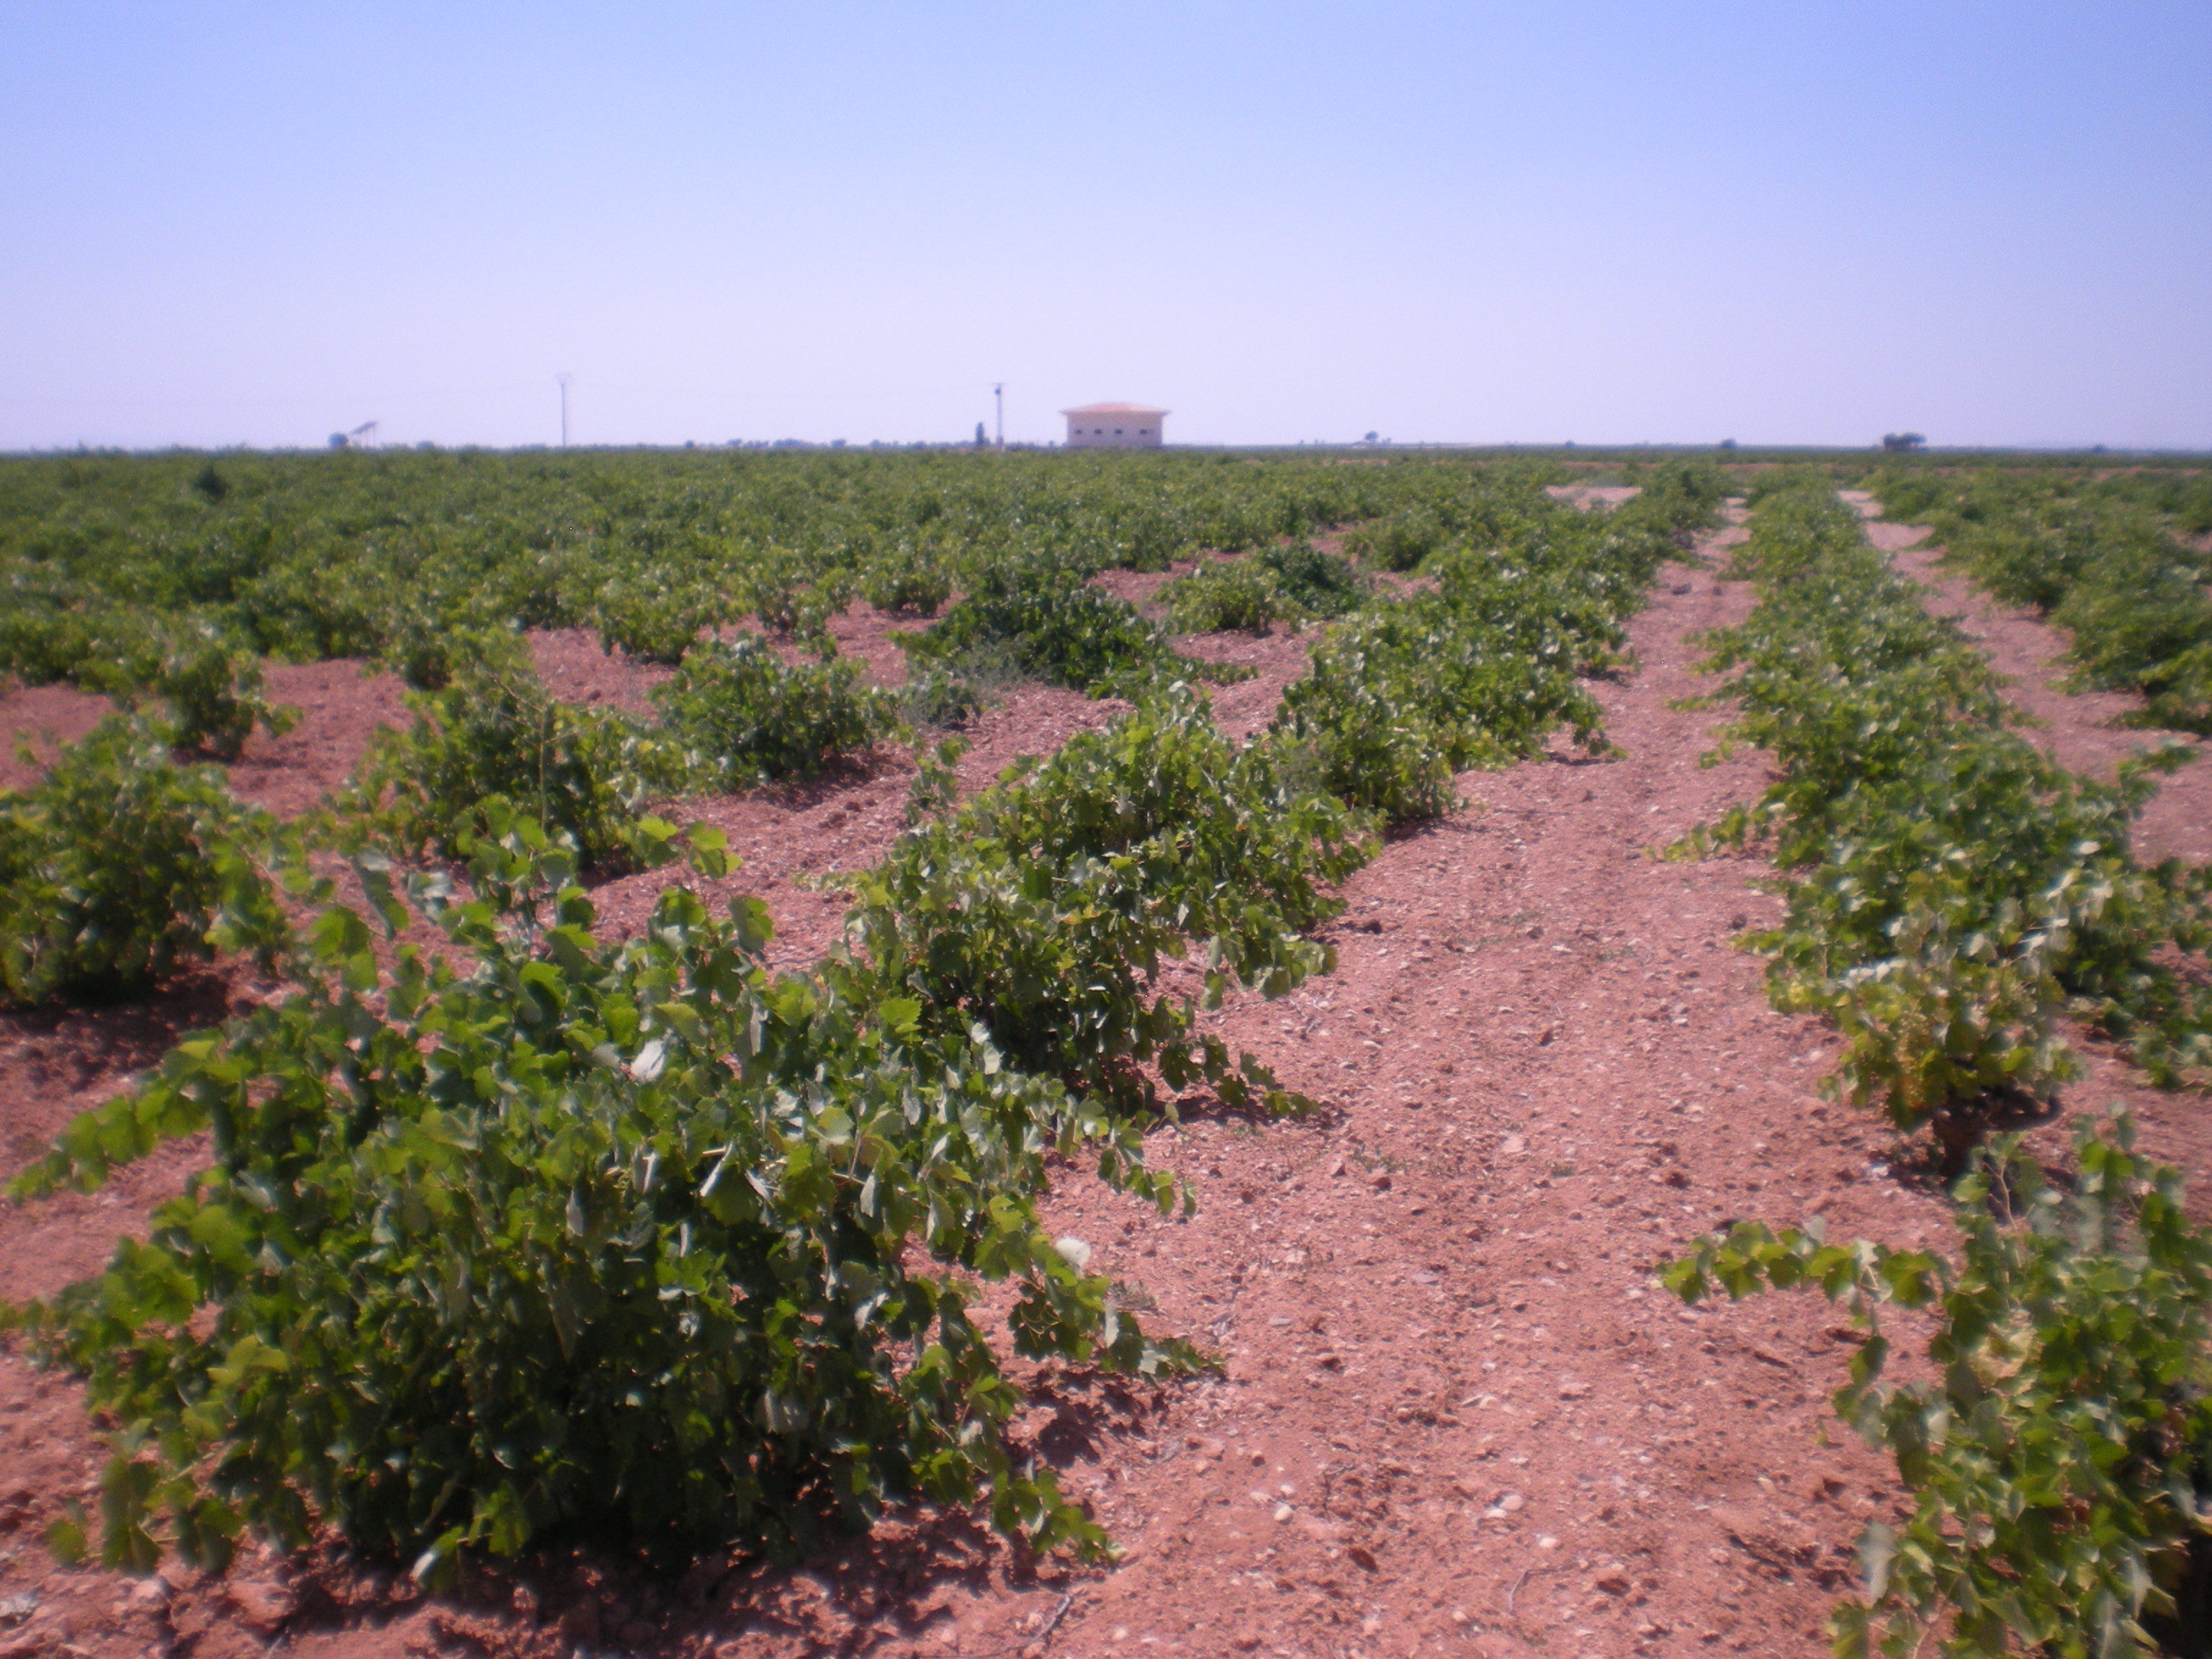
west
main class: Cropland
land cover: Vineyards
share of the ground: 10 - 25 %
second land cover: Other bare soil
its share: > 75 %
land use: Agriculture (excluding fallow land and kitchen gardens)
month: July
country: ES
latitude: 39.5544
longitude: -3.0647
